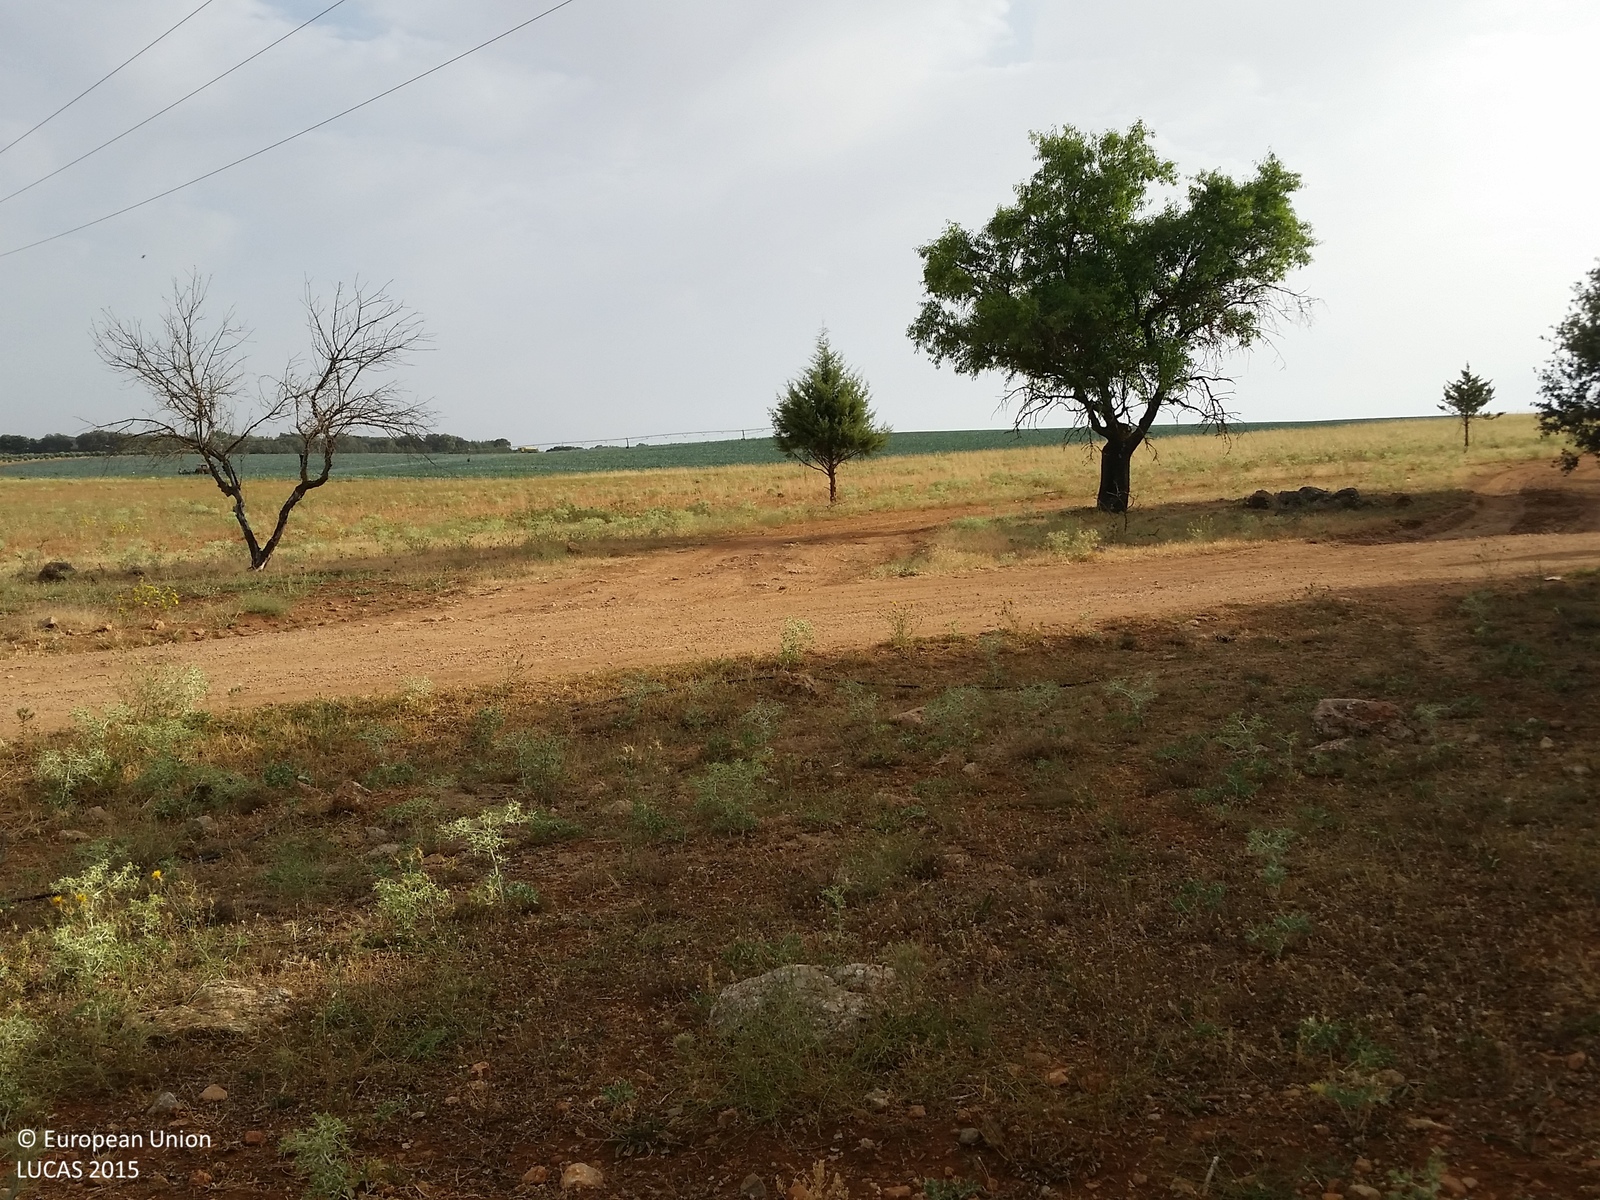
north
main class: Woodland
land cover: Broadleaved woodland
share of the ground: 50 - 75 %
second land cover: Spontaneously vegetated surfaces
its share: 25 - 50 %
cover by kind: broadleaved forest trees 60 %, herbaceous plants 30 %, unconsolidated bare surface 10 %
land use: Forestry
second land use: Fallow land
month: July
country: ES
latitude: 38.7438
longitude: -2.5550
